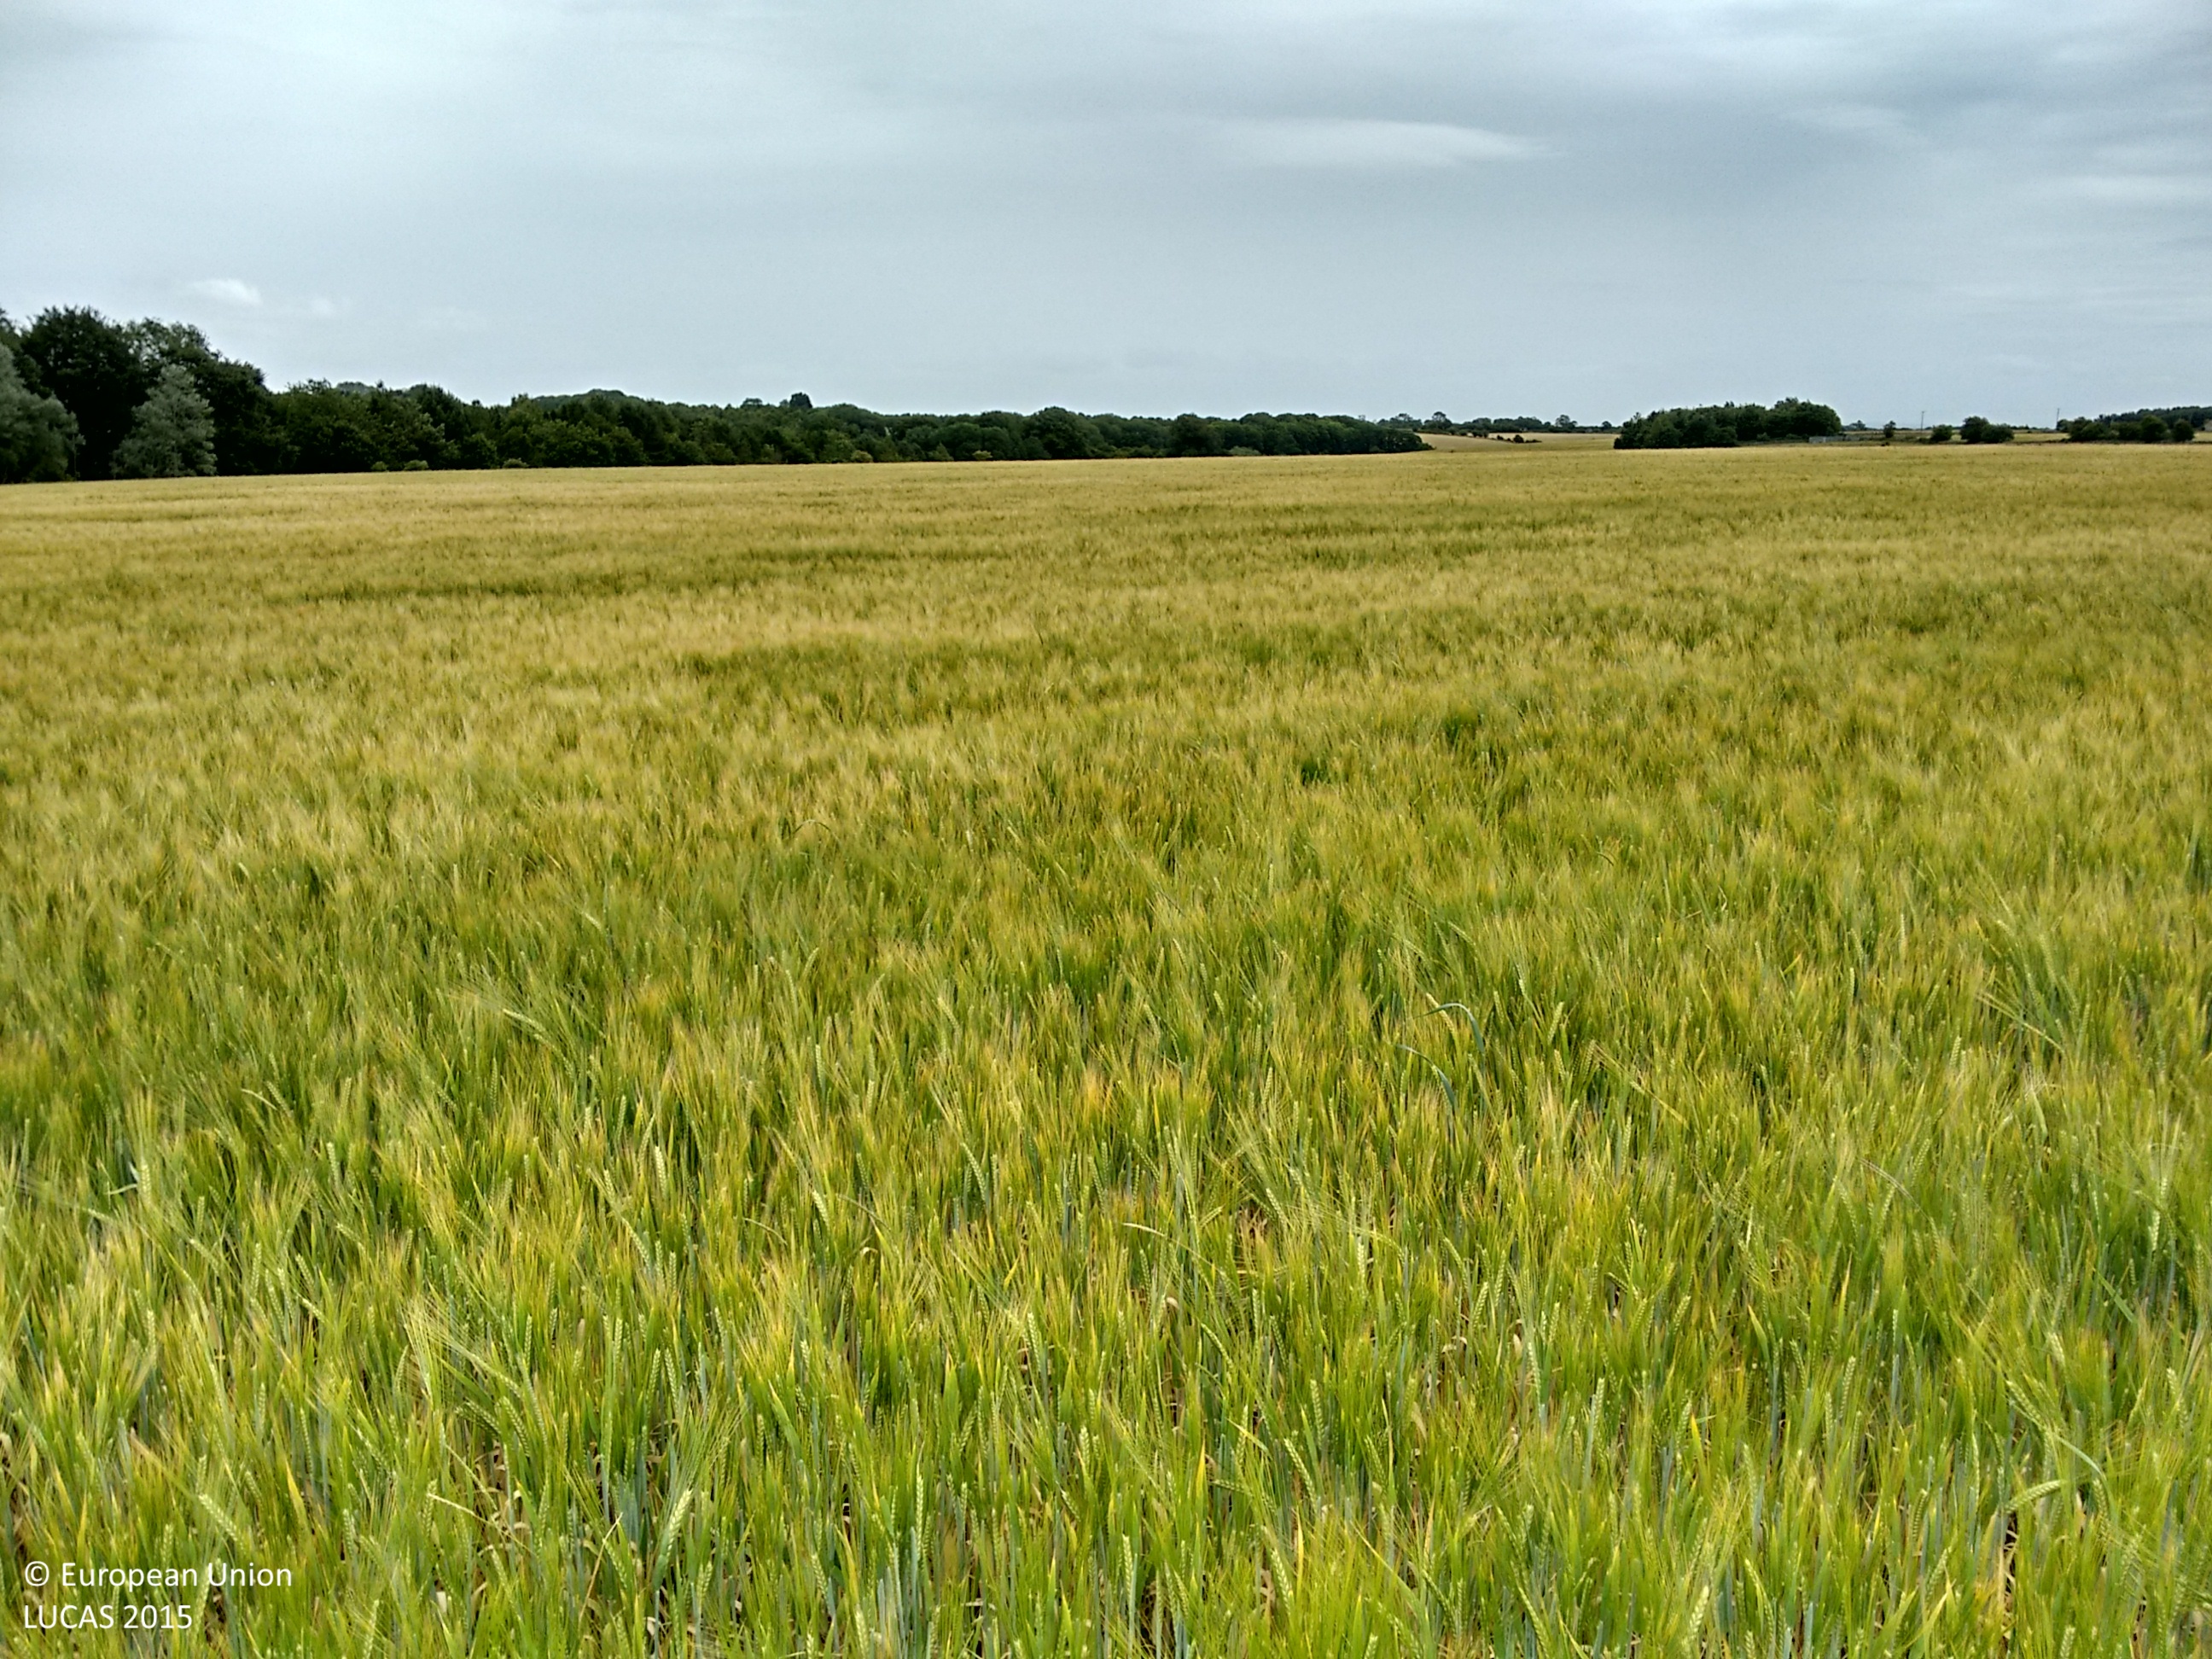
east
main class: Cropland
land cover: Barley
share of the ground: > 75 %
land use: Agriculture (excluding fallow land and kitchen gardens)
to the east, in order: Barley
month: July
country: GB
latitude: 51.7848
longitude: -1.6356
